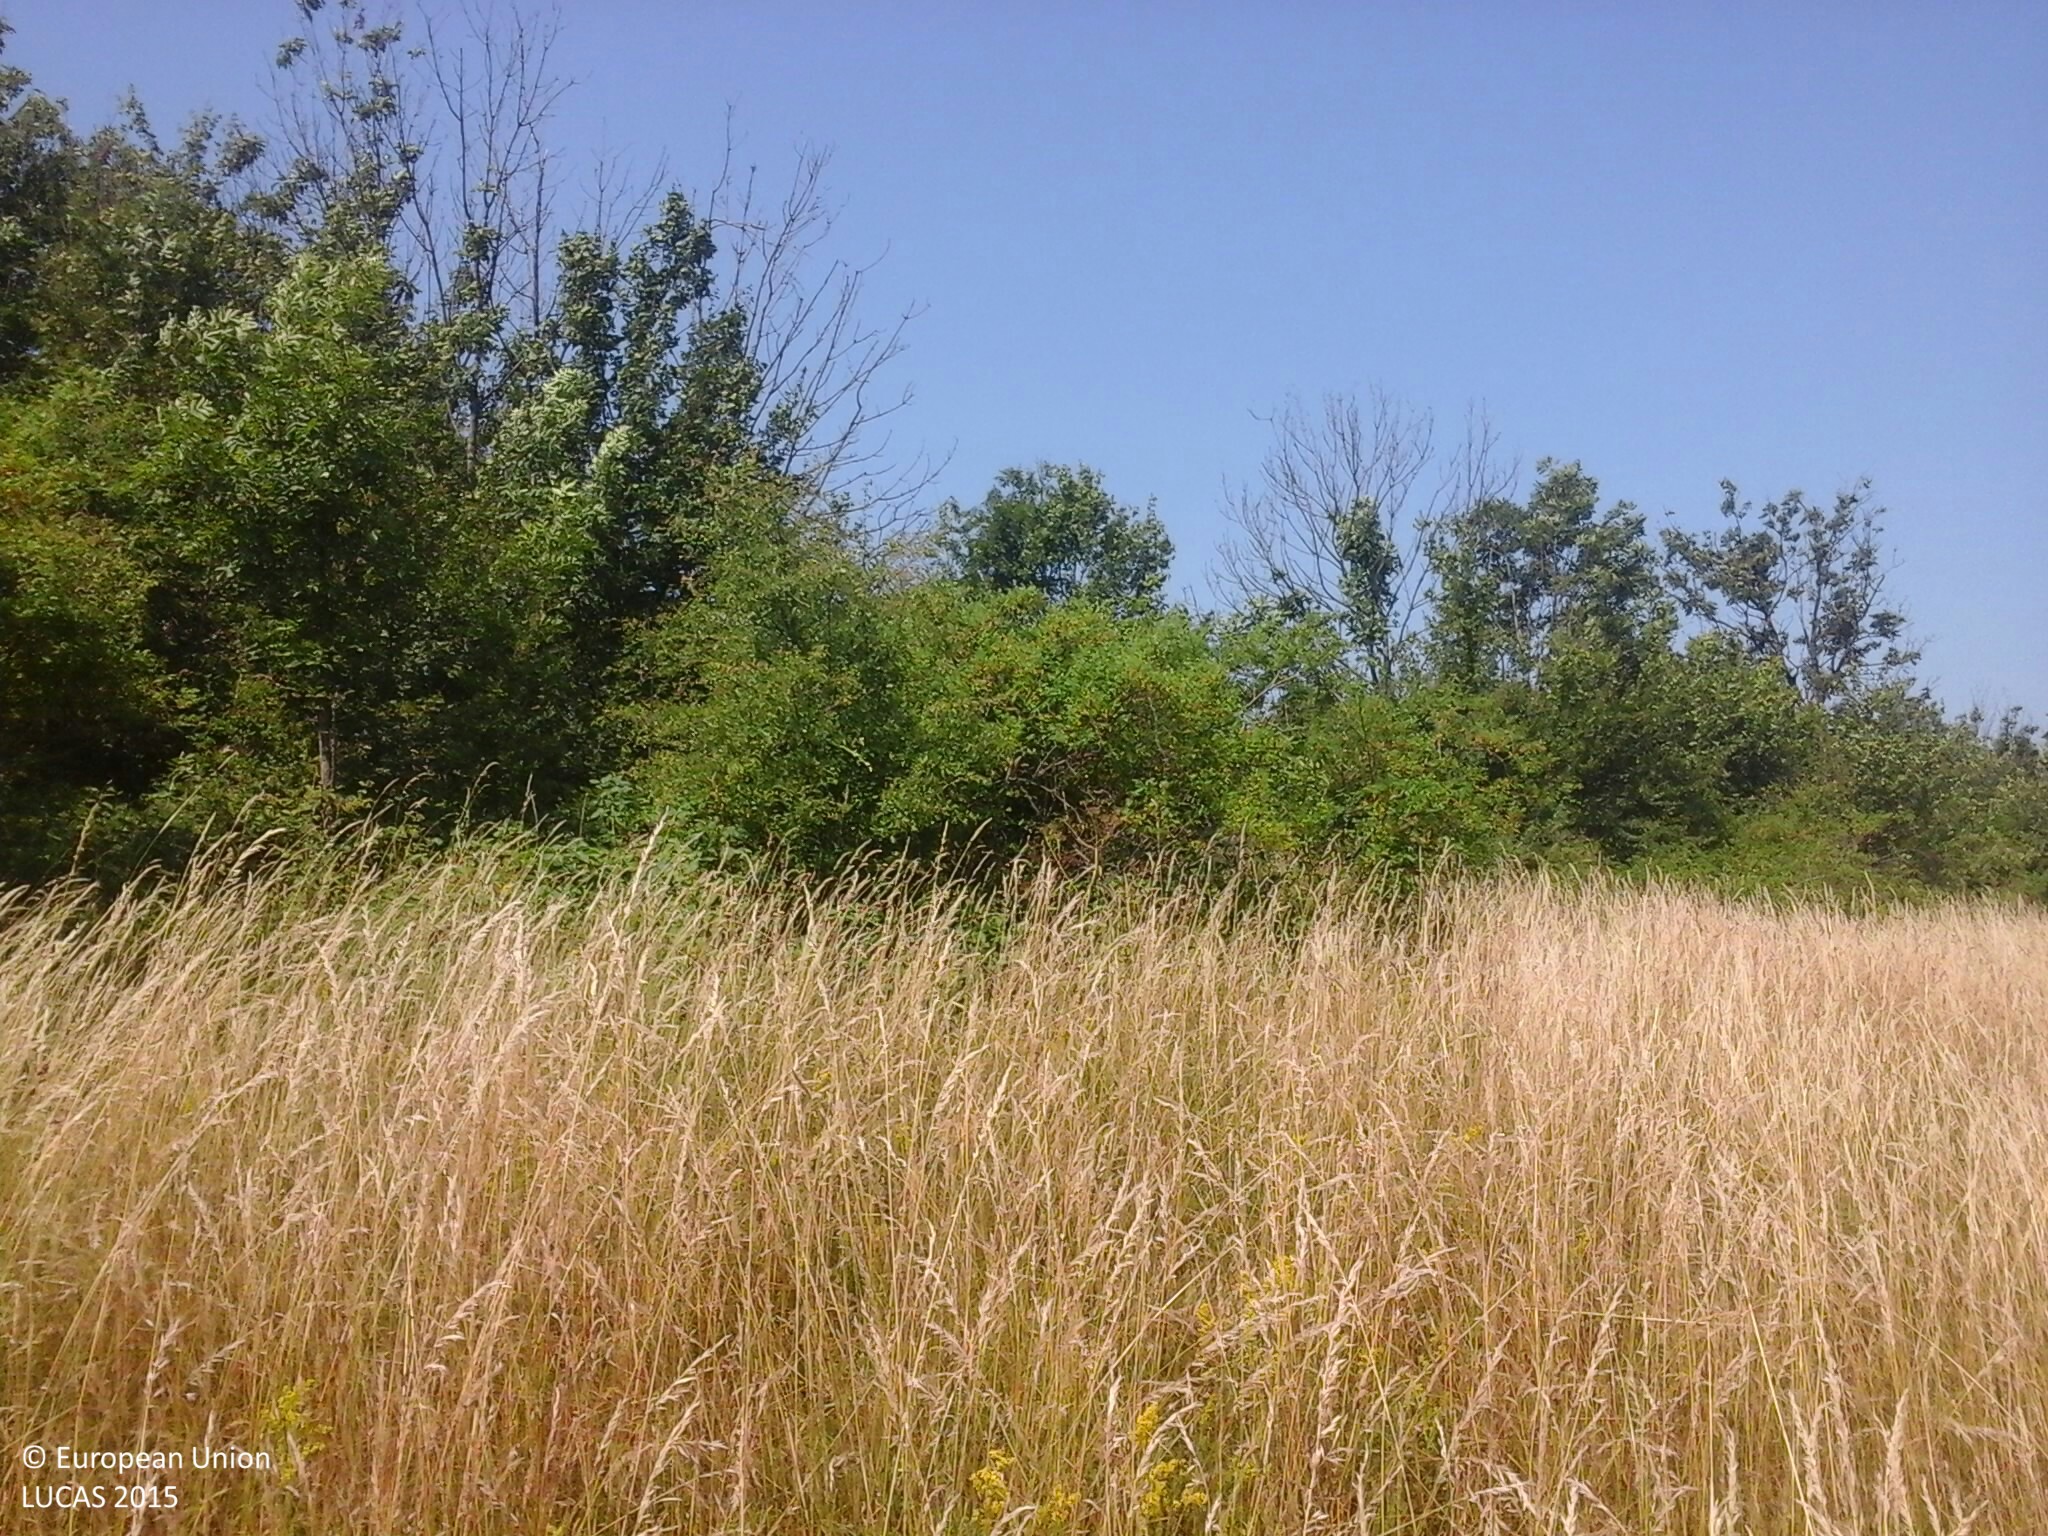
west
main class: Grassland
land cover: Grassland without tree/shrub cover
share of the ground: > 75 %
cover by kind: herbaceous plants 100 %
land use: Agriculture (excluding fallow land and kitchen gardens)
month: July
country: HU
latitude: 47.2011
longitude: 17.8634
